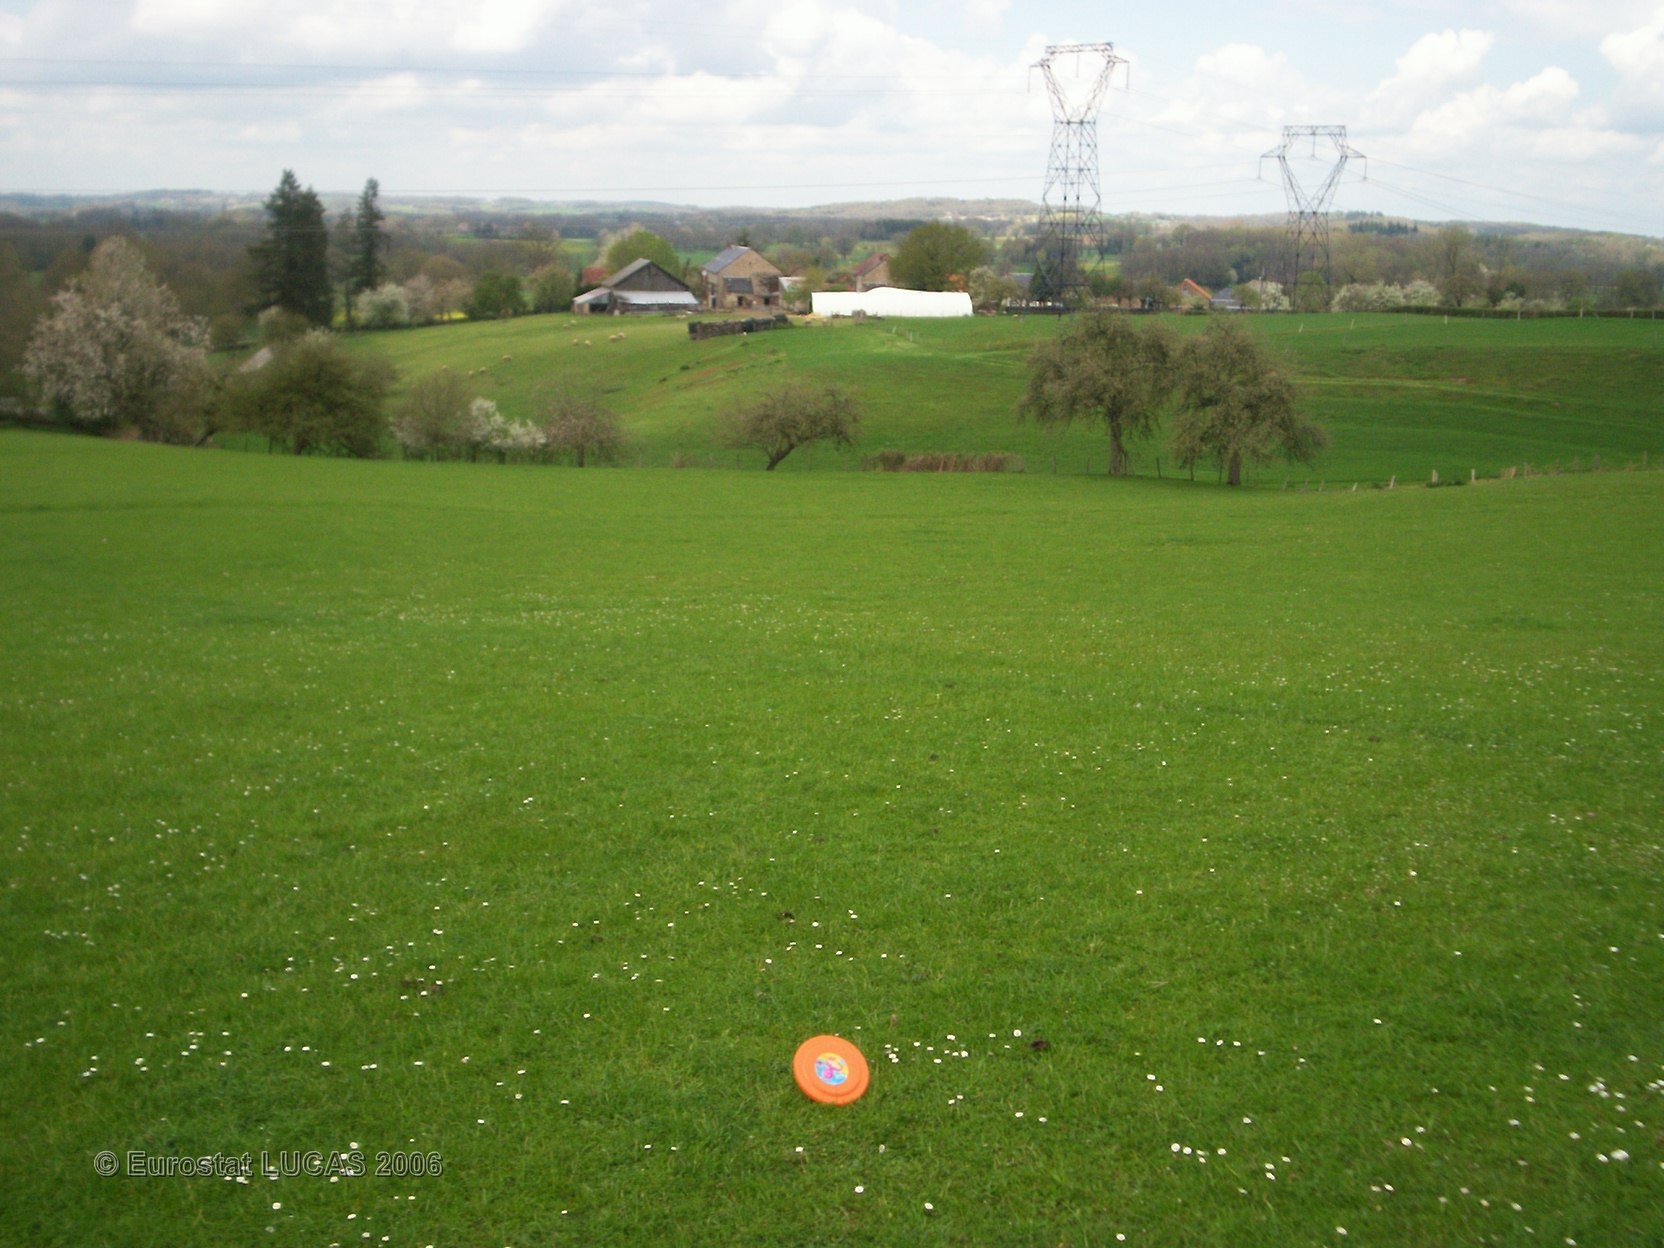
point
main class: Grassland
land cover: Grassland without tree/shrub cover
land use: Agriculture (excluding fallow land and kitchen gardens)
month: April
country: FR
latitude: 46.1881
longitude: 1.6609
